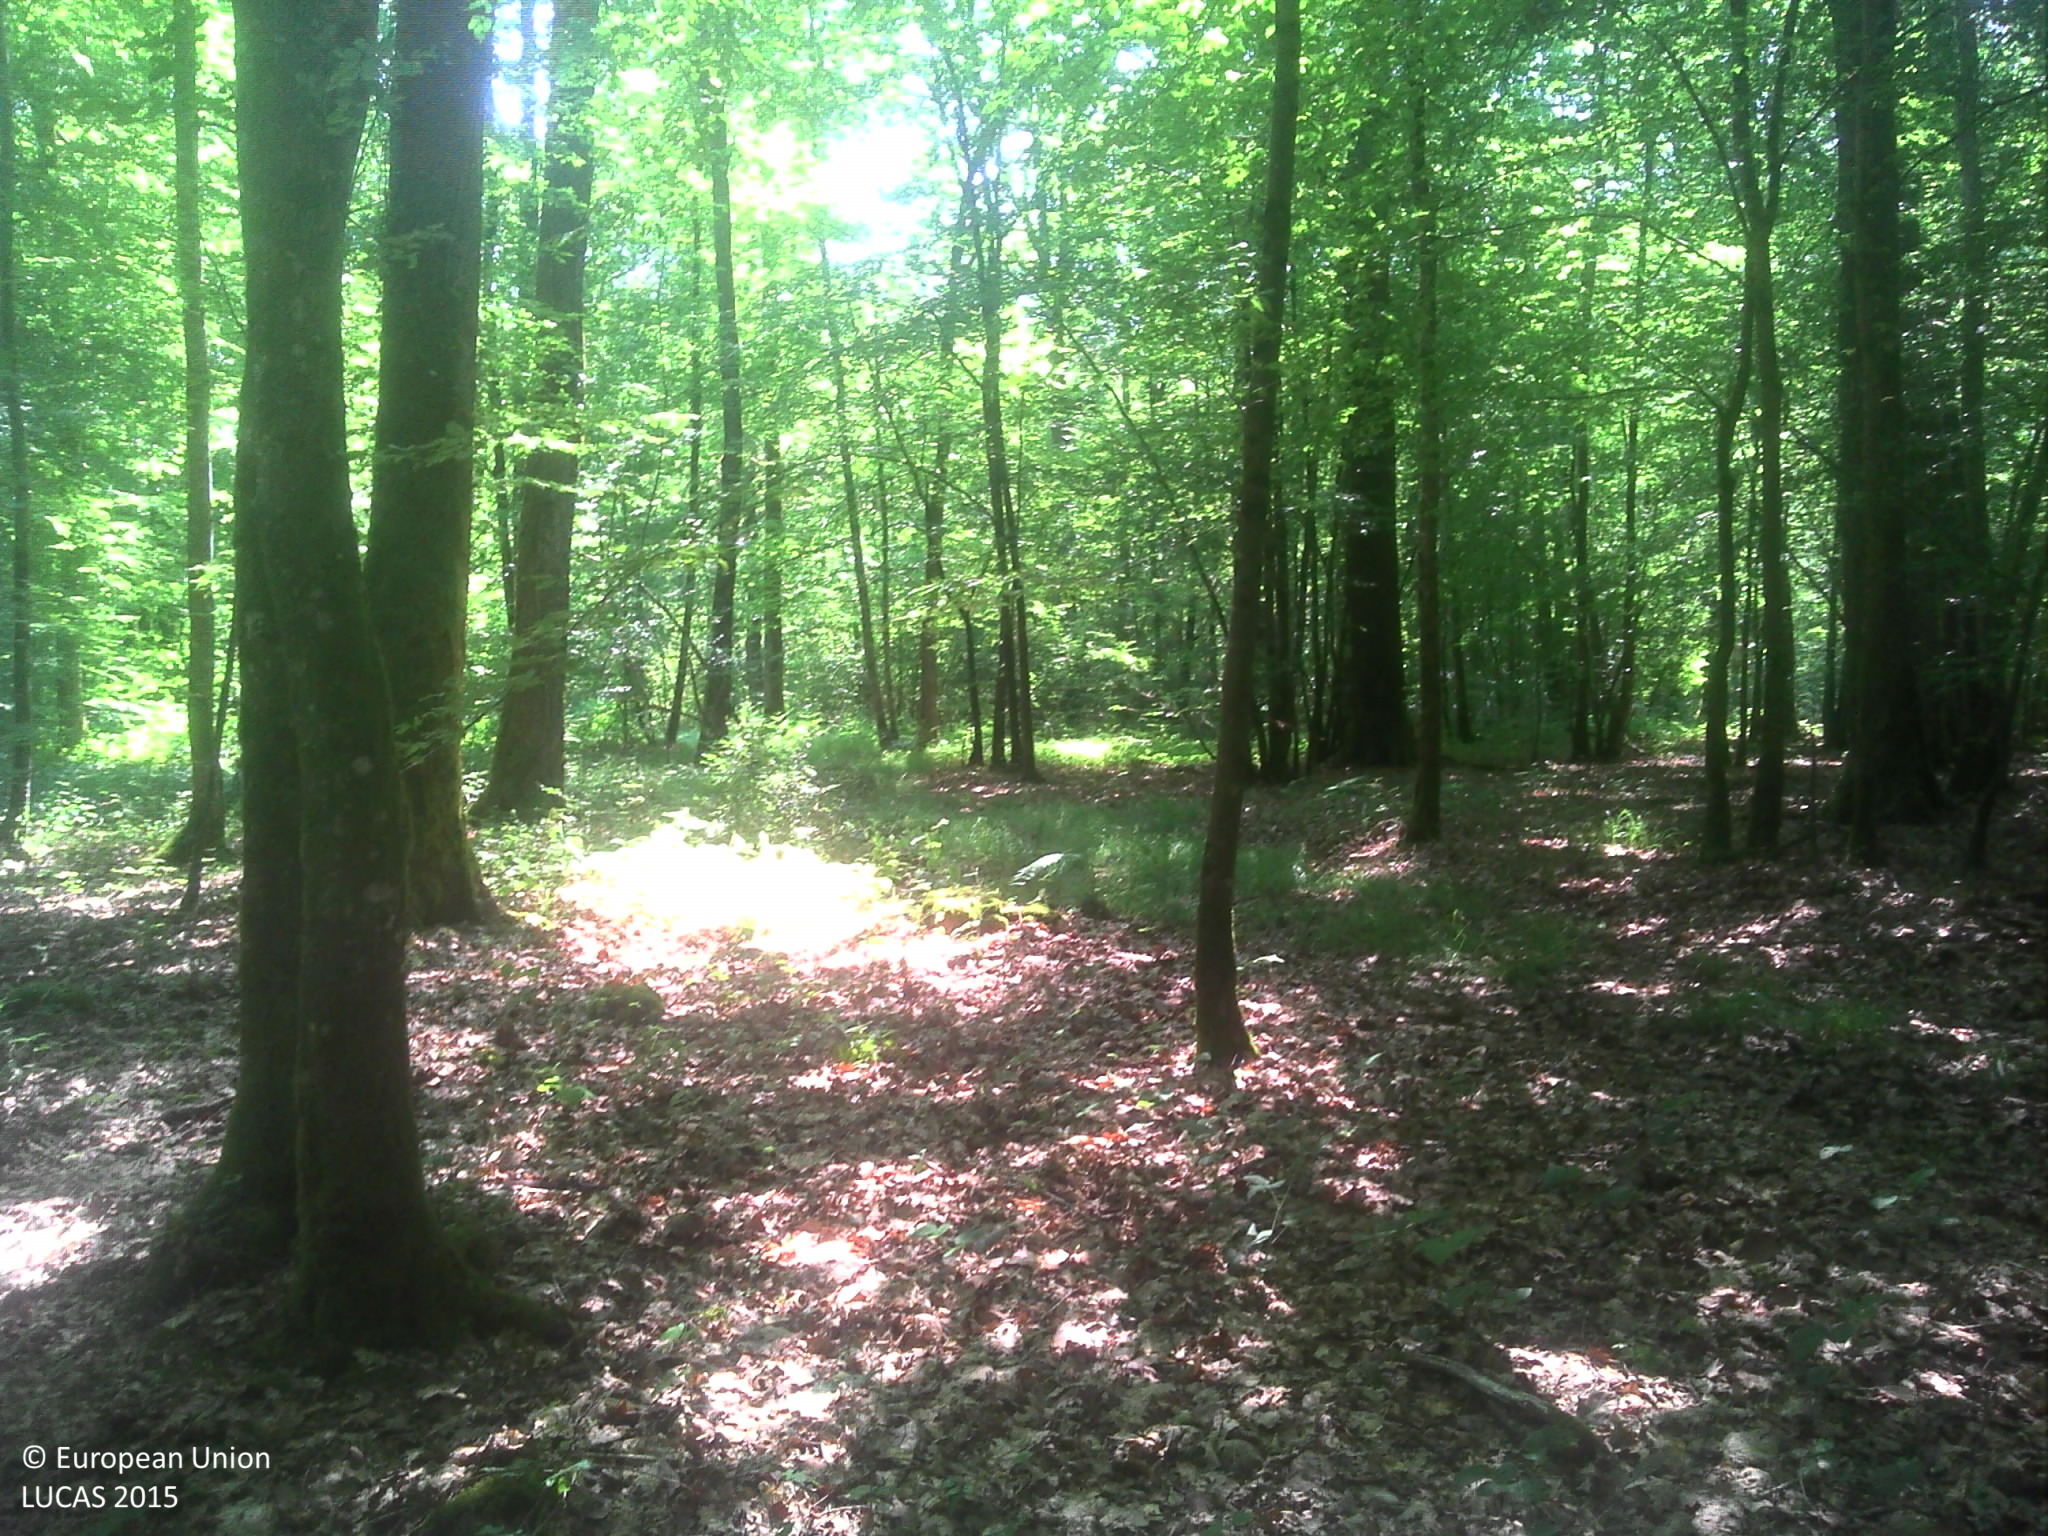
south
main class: Woodland
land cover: Broadleaved woodland
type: beech forest
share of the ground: > 75 %
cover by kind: broadleaved forest trees 90 %, herbaceous plants 10 %
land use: Forestry
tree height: > 5 m
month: June
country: FR
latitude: 48.4649
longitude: 4.8724
